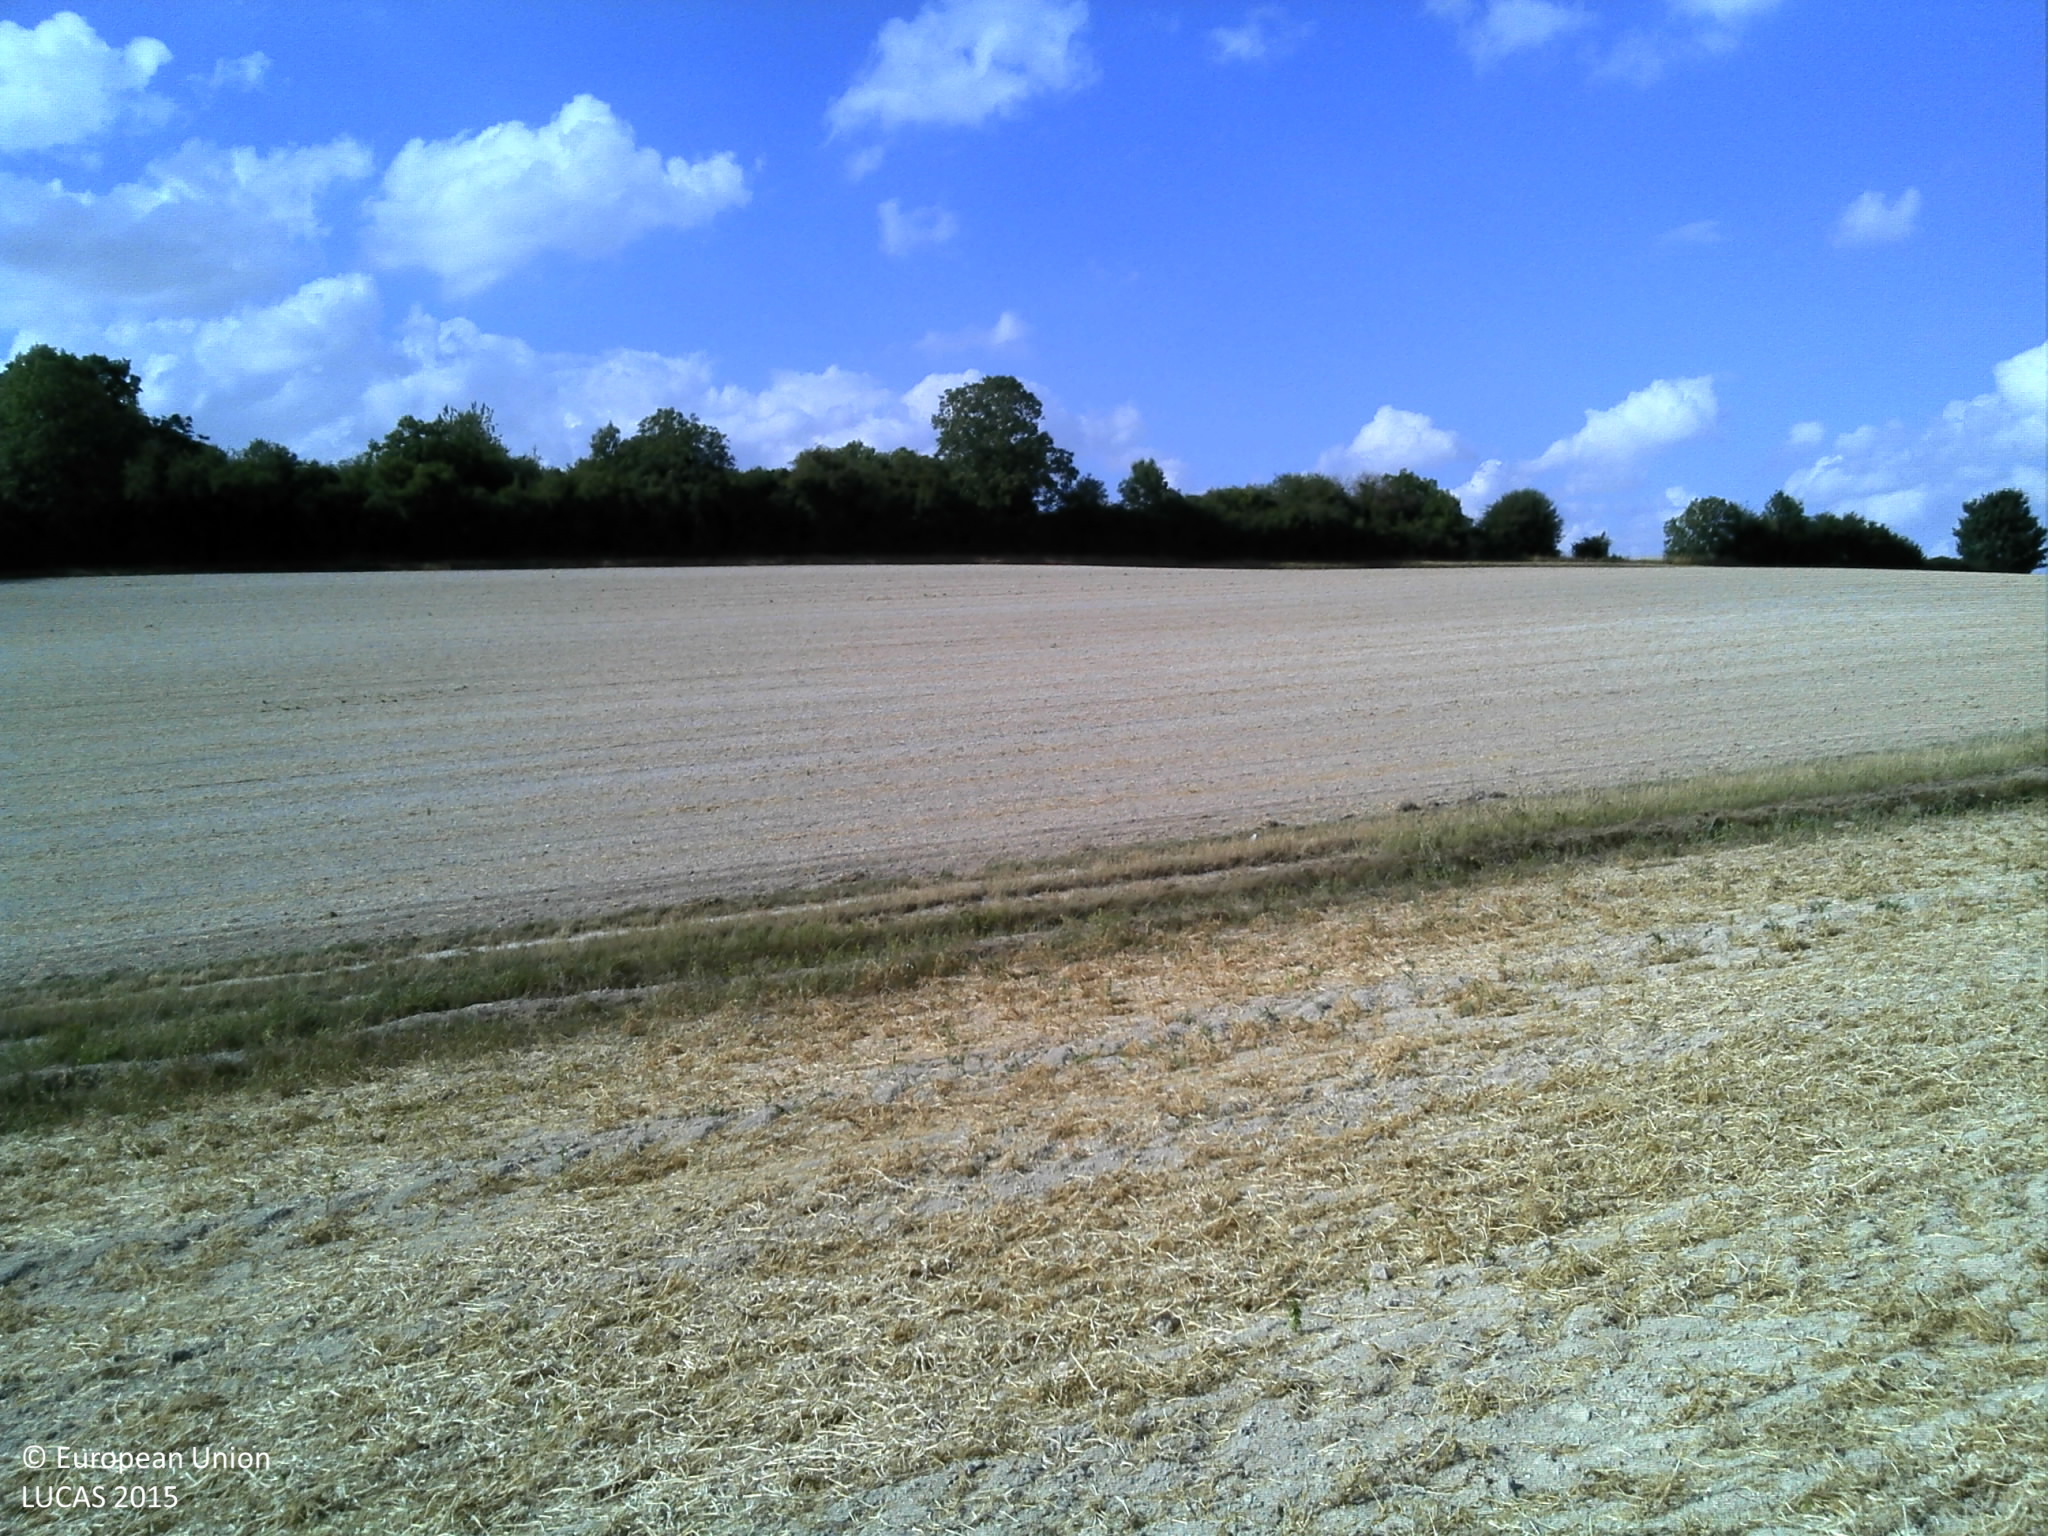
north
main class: Cropland
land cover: Dry pulses
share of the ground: > 75 %
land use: Agriculture (excluding fallow land and kitchen gardens)
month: August
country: FR
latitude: 48.7762
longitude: 4.5948
